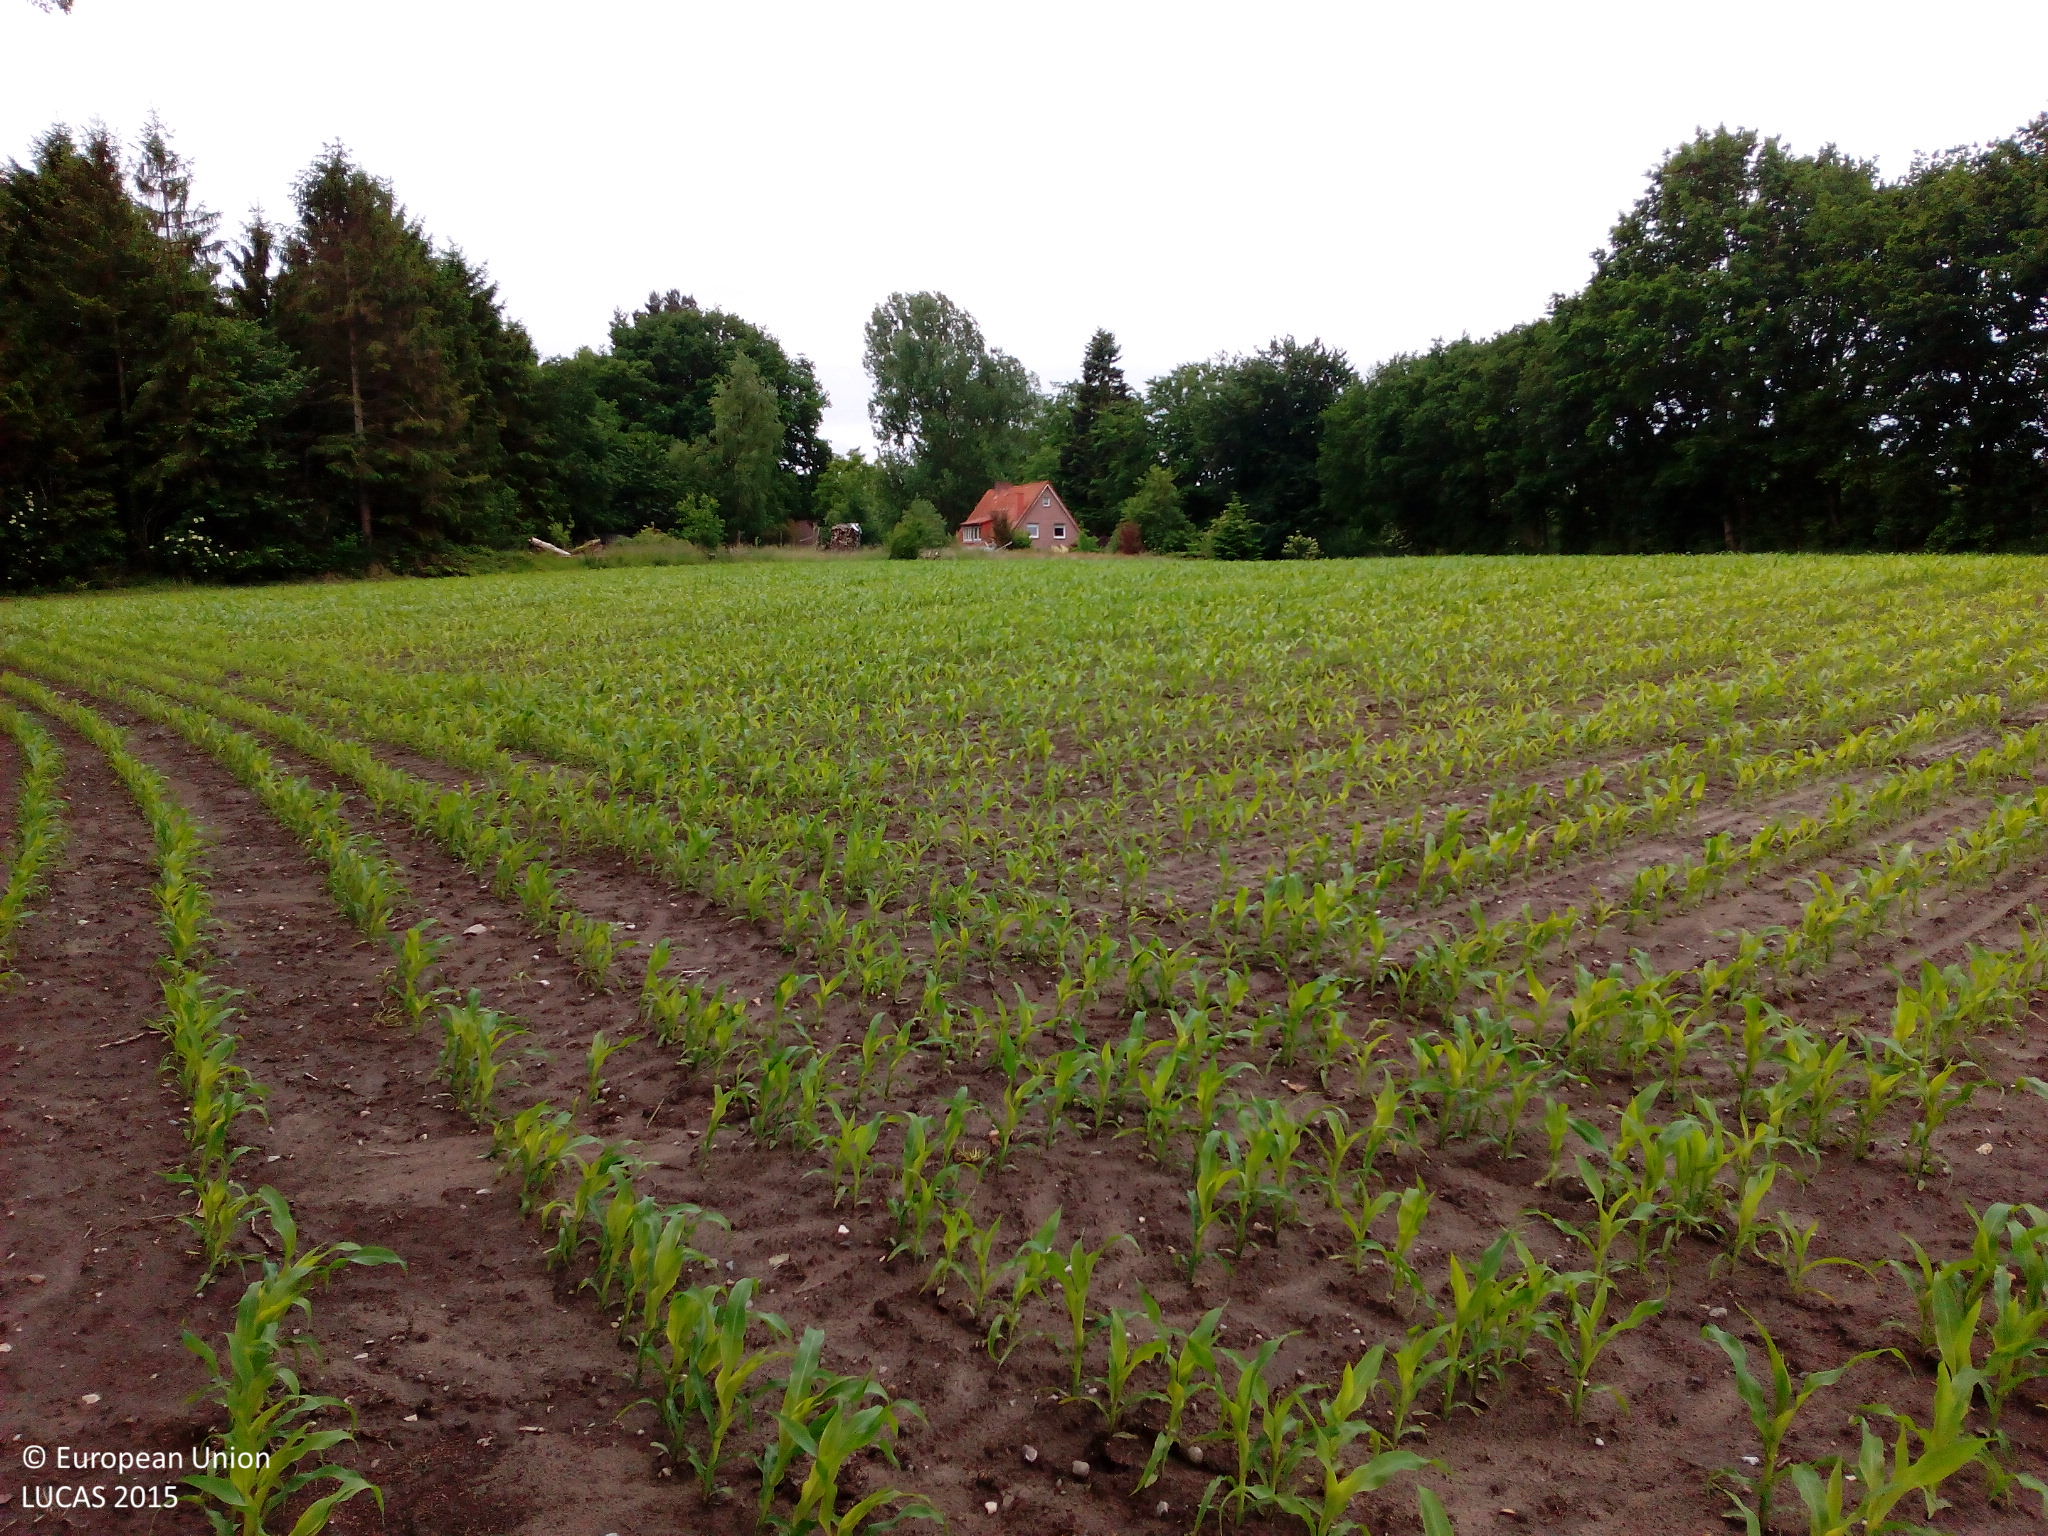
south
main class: Cropland
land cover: Maize
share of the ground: > 75 %
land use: Agriculture (excluding fallow land and kitchen gardens)
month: June
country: DE
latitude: 53.7219
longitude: 9.0760
